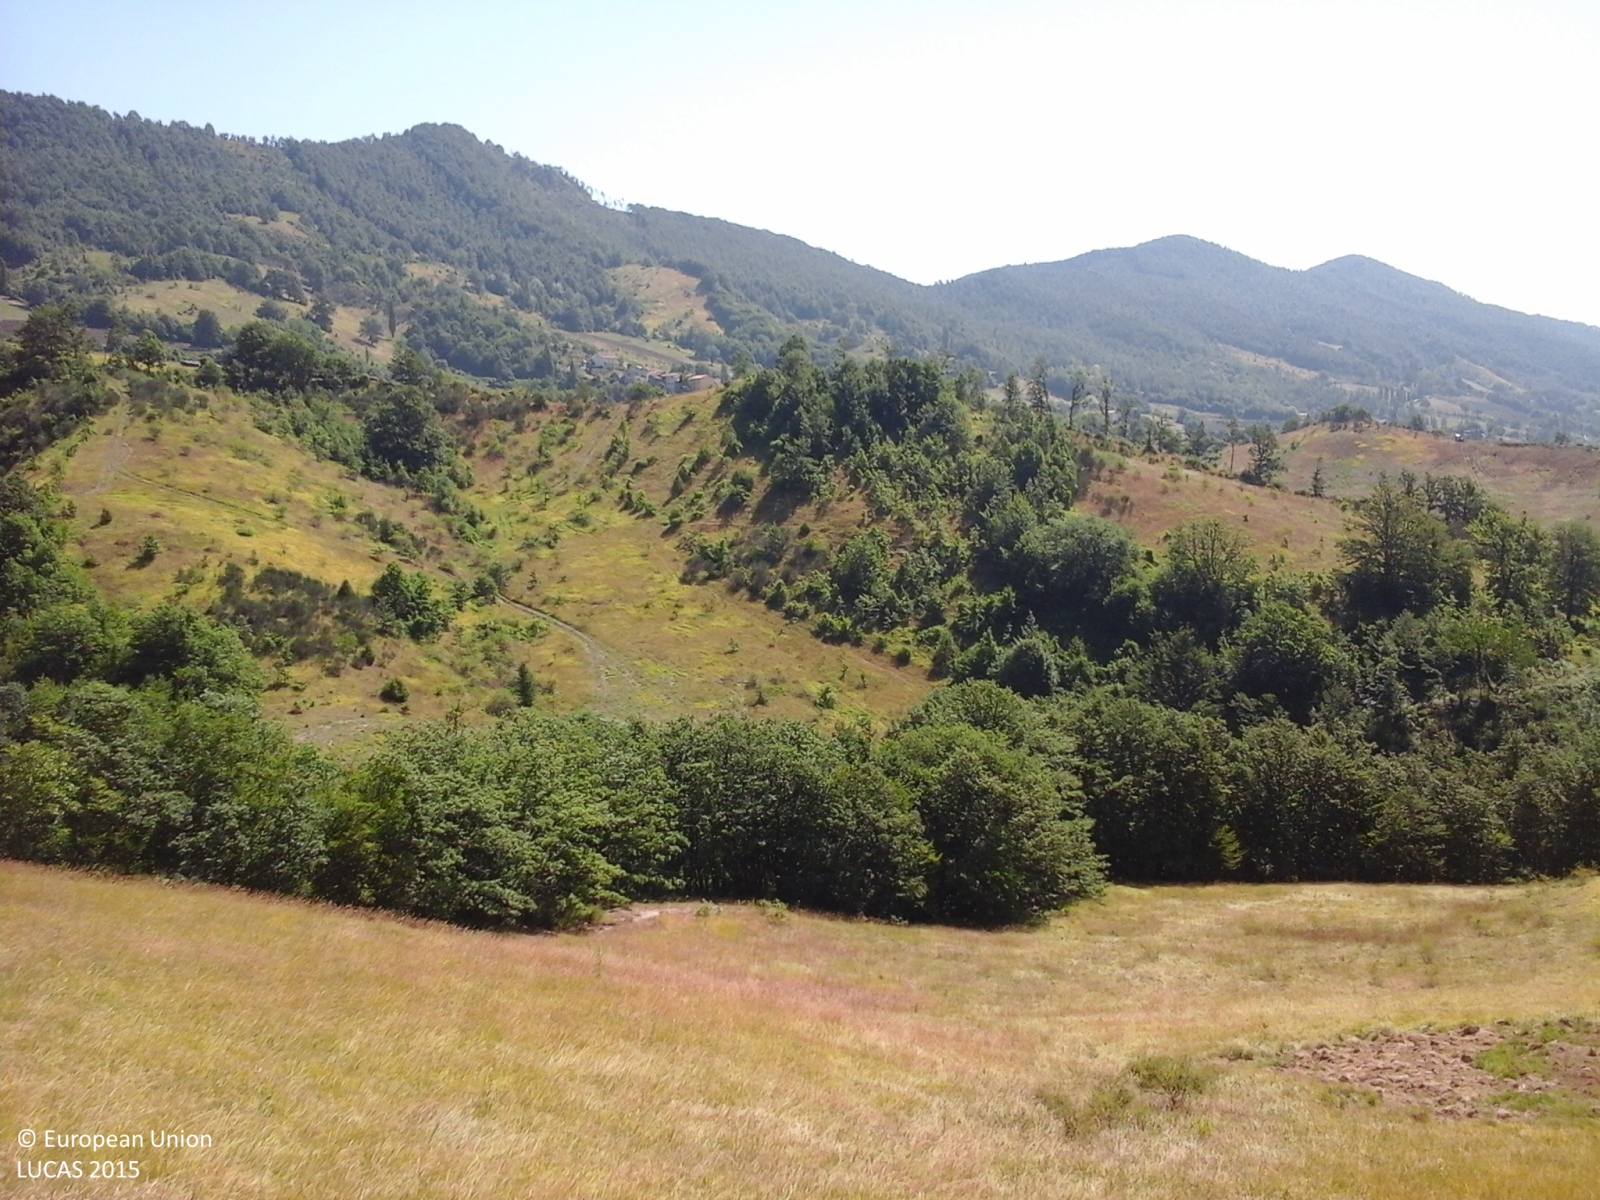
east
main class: Grassland
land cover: Grassland without tree/shrub cover
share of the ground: > 75 %
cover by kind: herbaceous plants 100 %
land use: Agriculture (excluding fallow land and kitchen gardens)
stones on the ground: 10 - 25 %
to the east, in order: Grassland without tree/shrub cover; Broadleaved woodland; Rivers and streams; Broadleaved woodland; Grassland with sparse tree/shrub cover
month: August
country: IT
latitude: 43.4528
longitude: 12.5513
